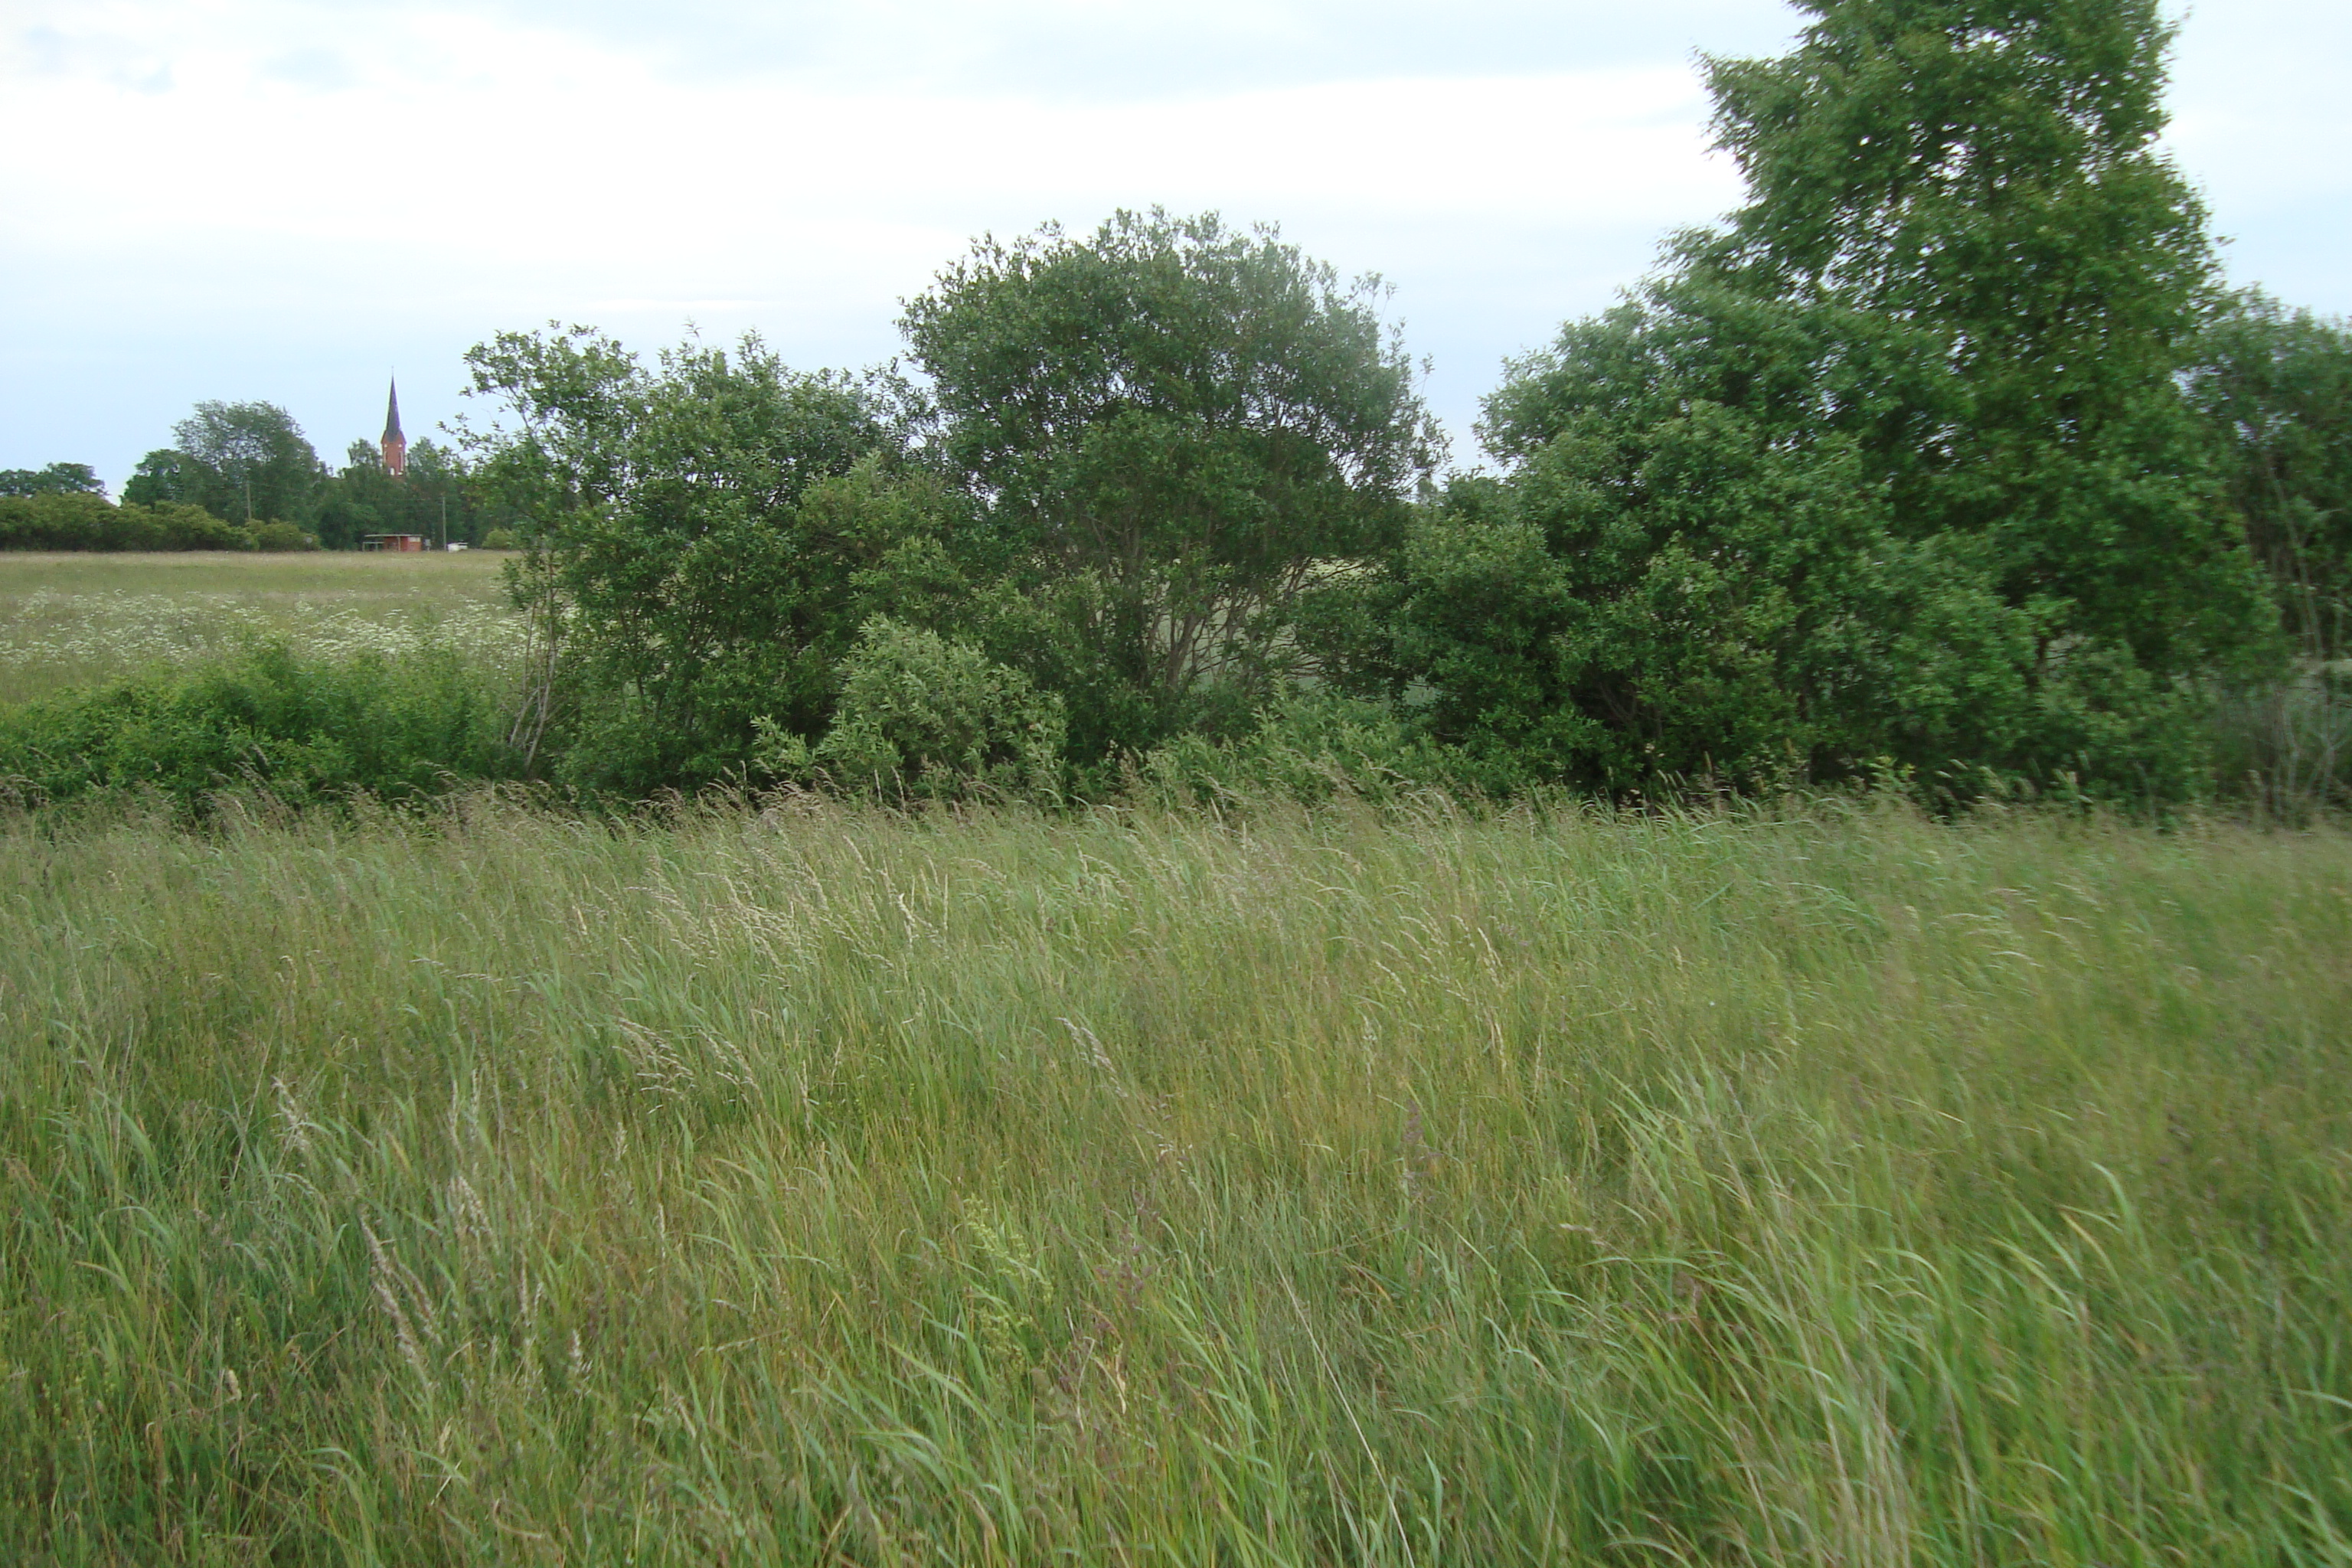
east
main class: Grassland
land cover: Grassland without tree/shrub cover
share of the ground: > 75 %
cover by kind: herbaceous plants 100 %
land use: Agriculture (excluding fallow land and kitchen gardens)
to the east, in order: Grassland without tree/shrub cover; Abandoned hedges; Ditches and canals; Abandoned hedges; Grassland without tree/shrub cover
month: June
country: LV
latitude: 57.2387
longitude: 26.3952
